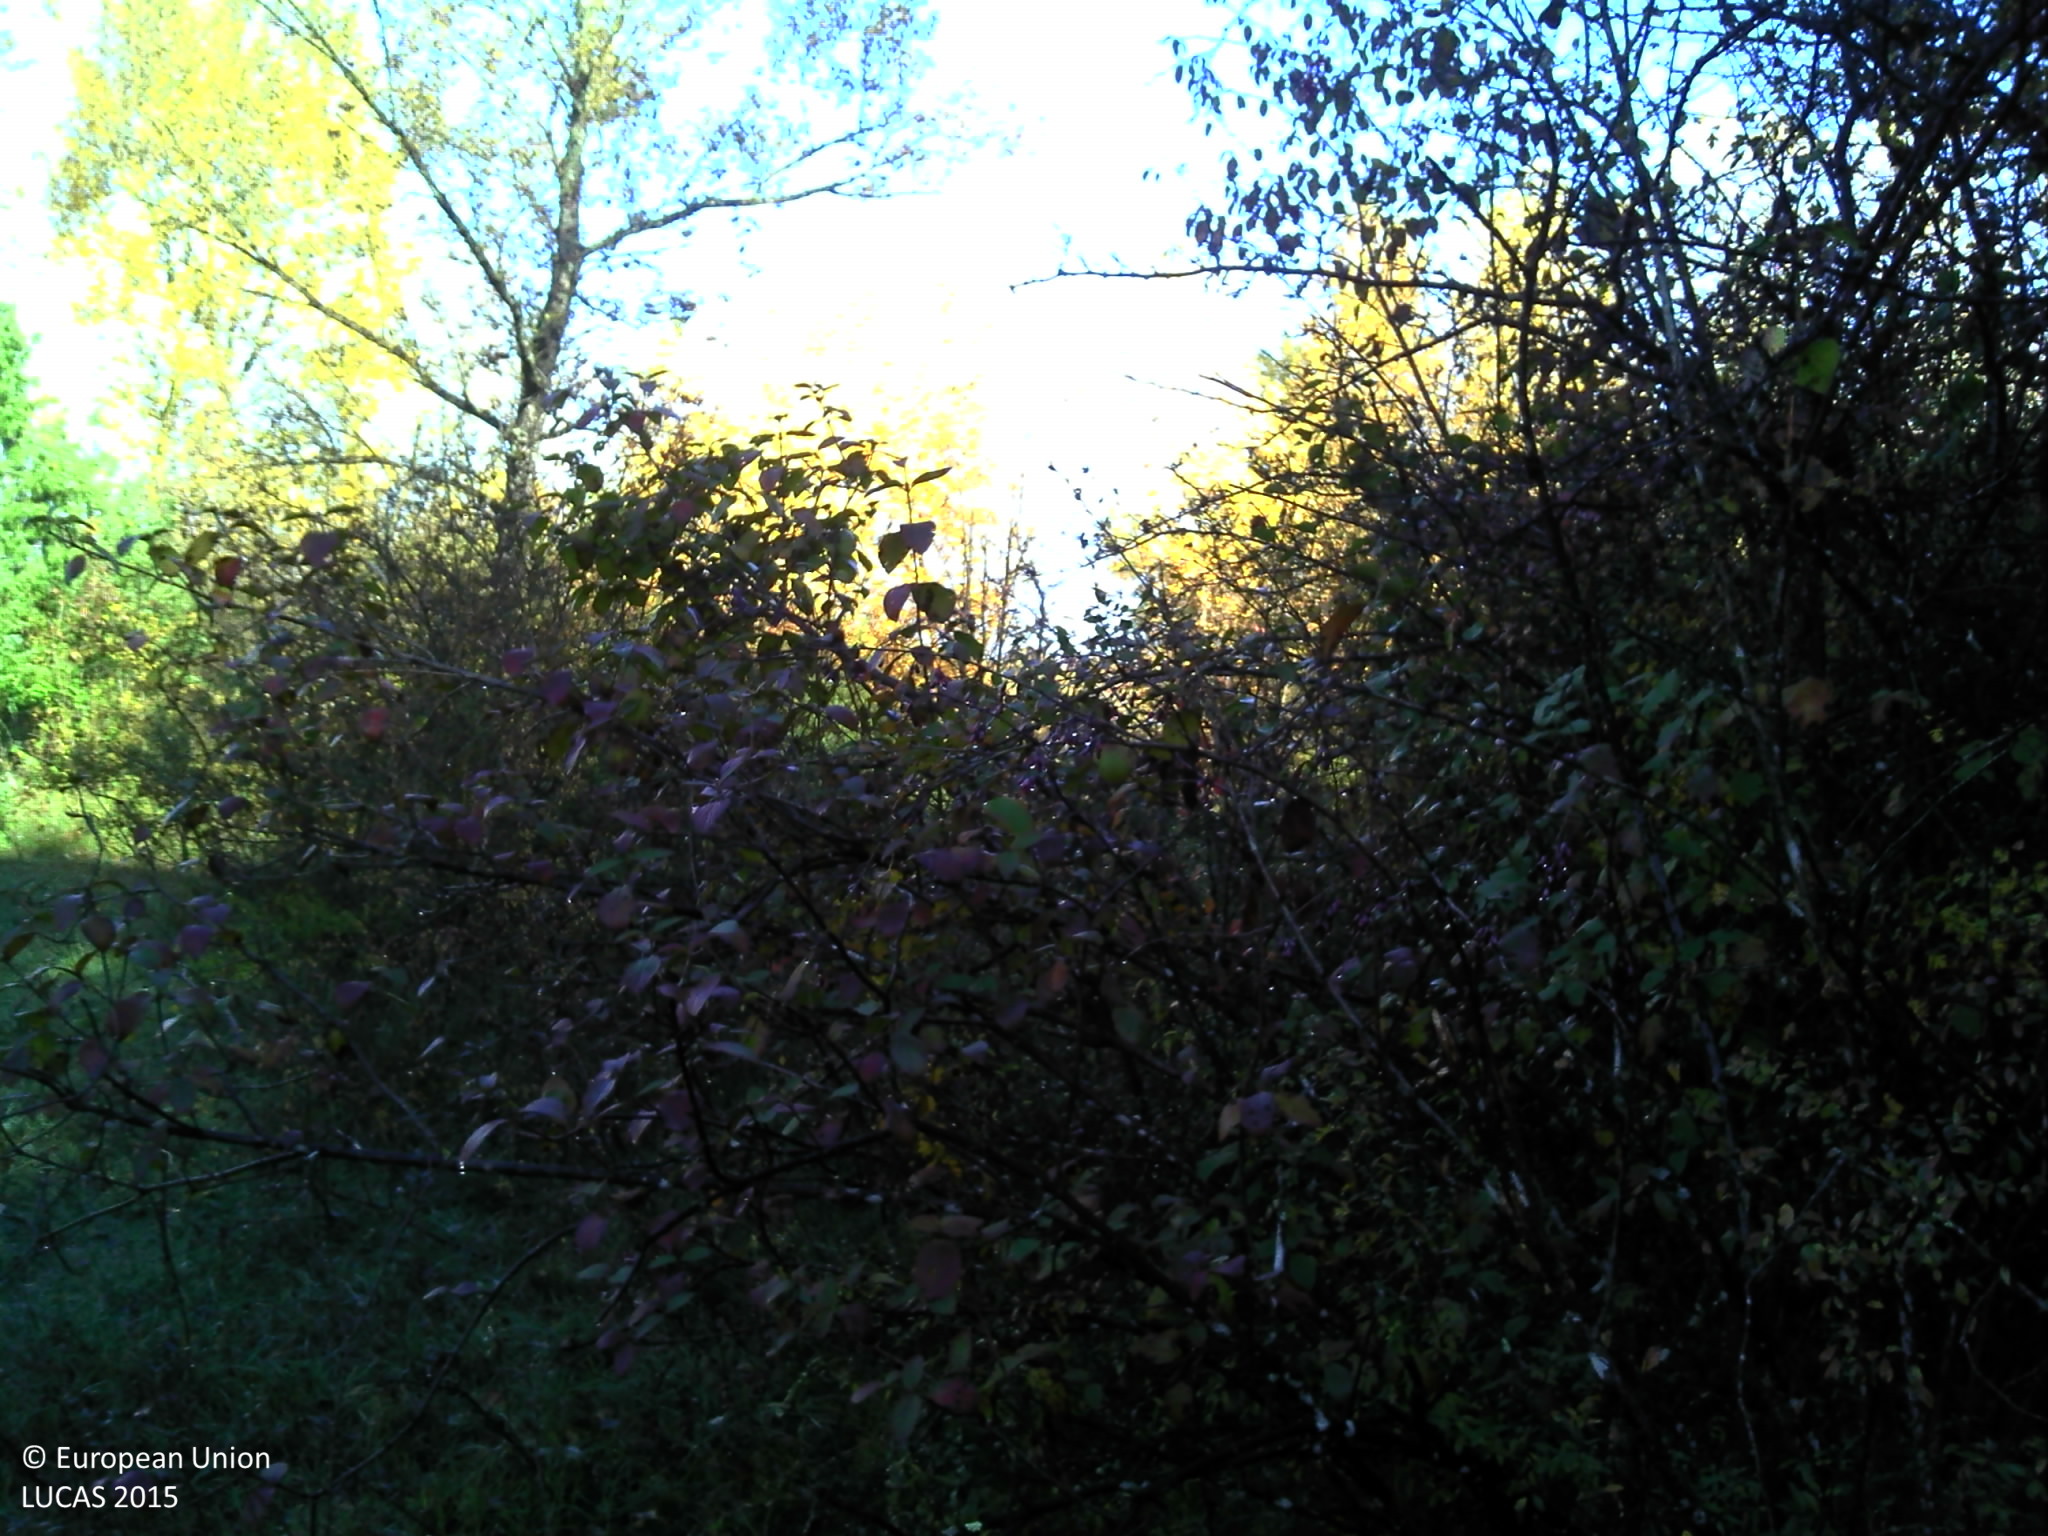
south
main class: Shrubland
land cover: Shrubland with sparse tree cover
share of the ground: > 75 %
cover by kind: shrubs 80 %, herbaceous plants 10 %, broadleaved forest trees 5 %, lichens and mosses 5 %
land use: Agriculture (excluding fallow land and kitchen gardens)
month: October
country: FR
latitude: 45.9949
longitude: 5.2909
